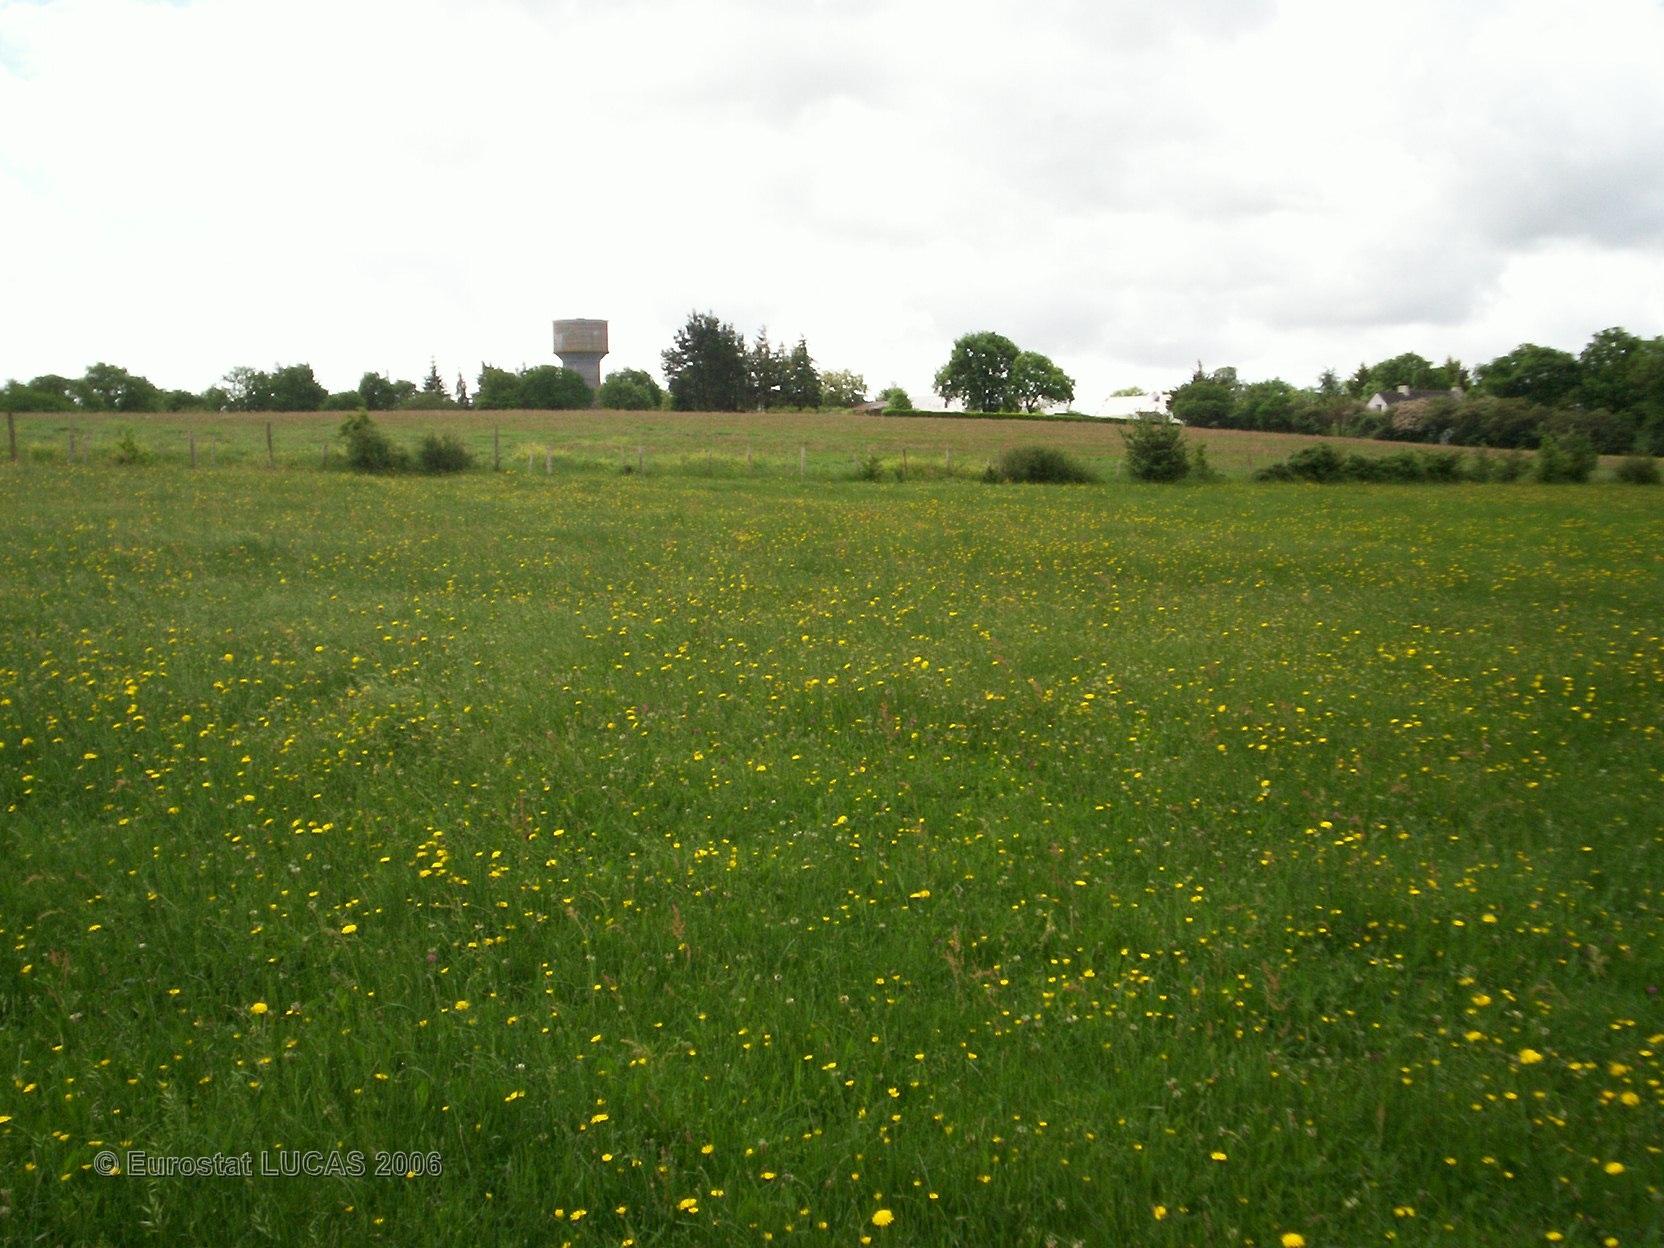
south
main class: Grassland
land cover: Grassland without tree/shrub cover
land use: Agriculture (excluding fallow land and kitchen gardens)
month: May
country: FR
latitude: 47.4031
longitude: -2.1493
